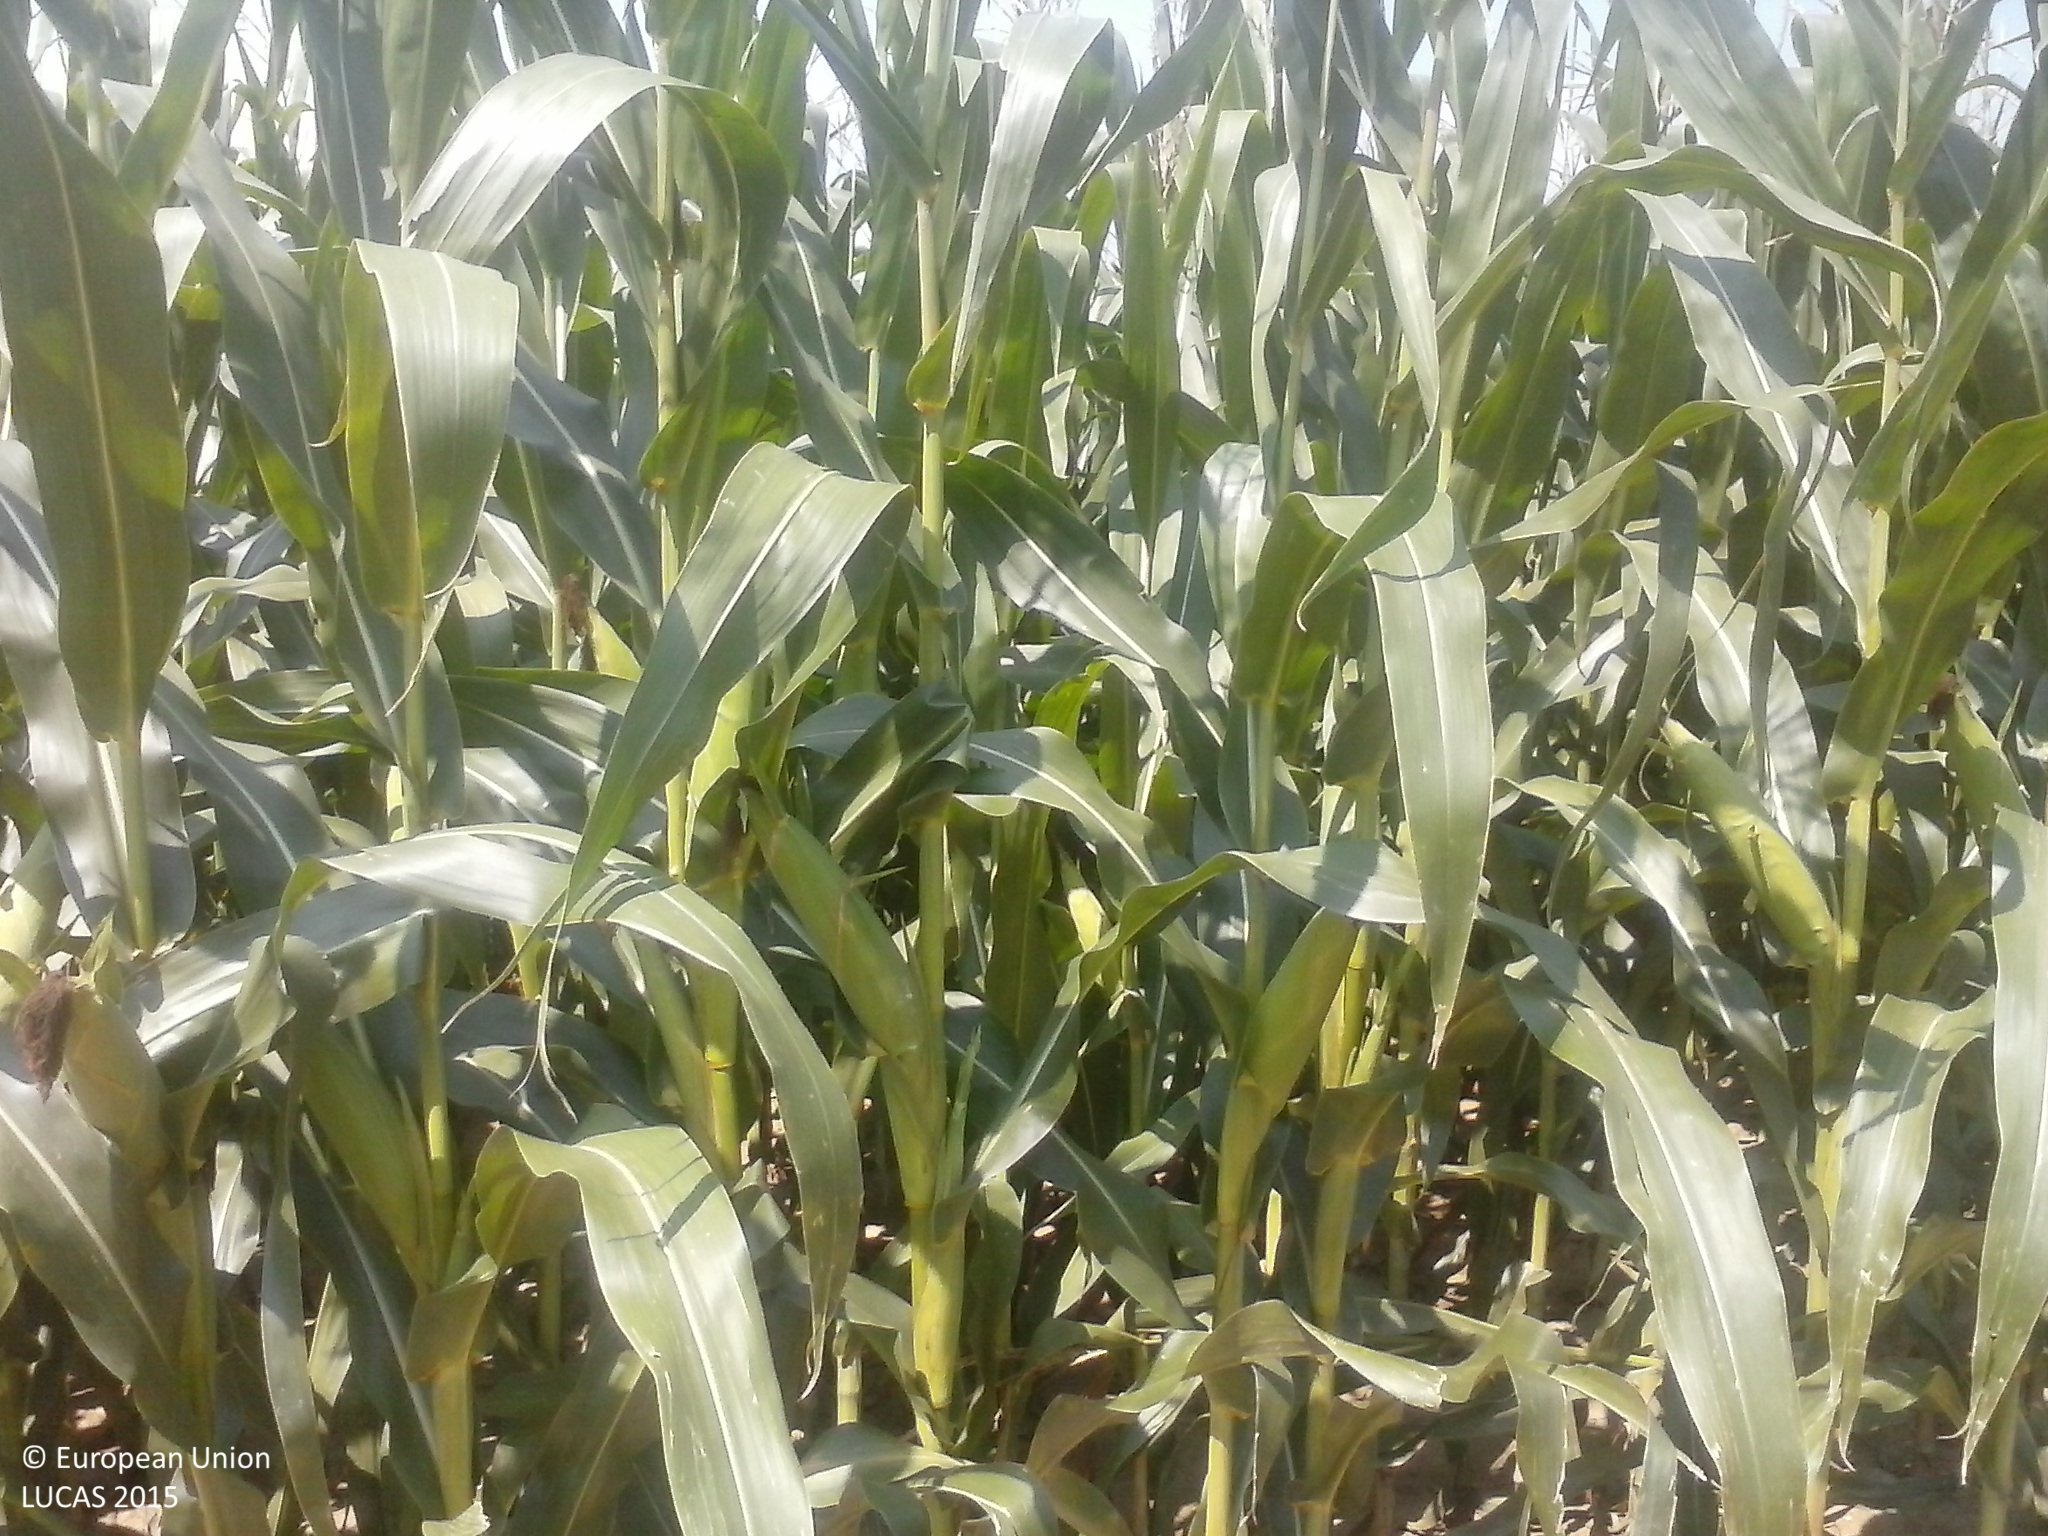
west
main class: Cropland
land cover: Maize
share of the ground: > 75 %
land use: Agriculture (excluding fallow land and kitchen gardens)
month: August
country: HU
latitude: 46.1697
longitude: 17.8675
